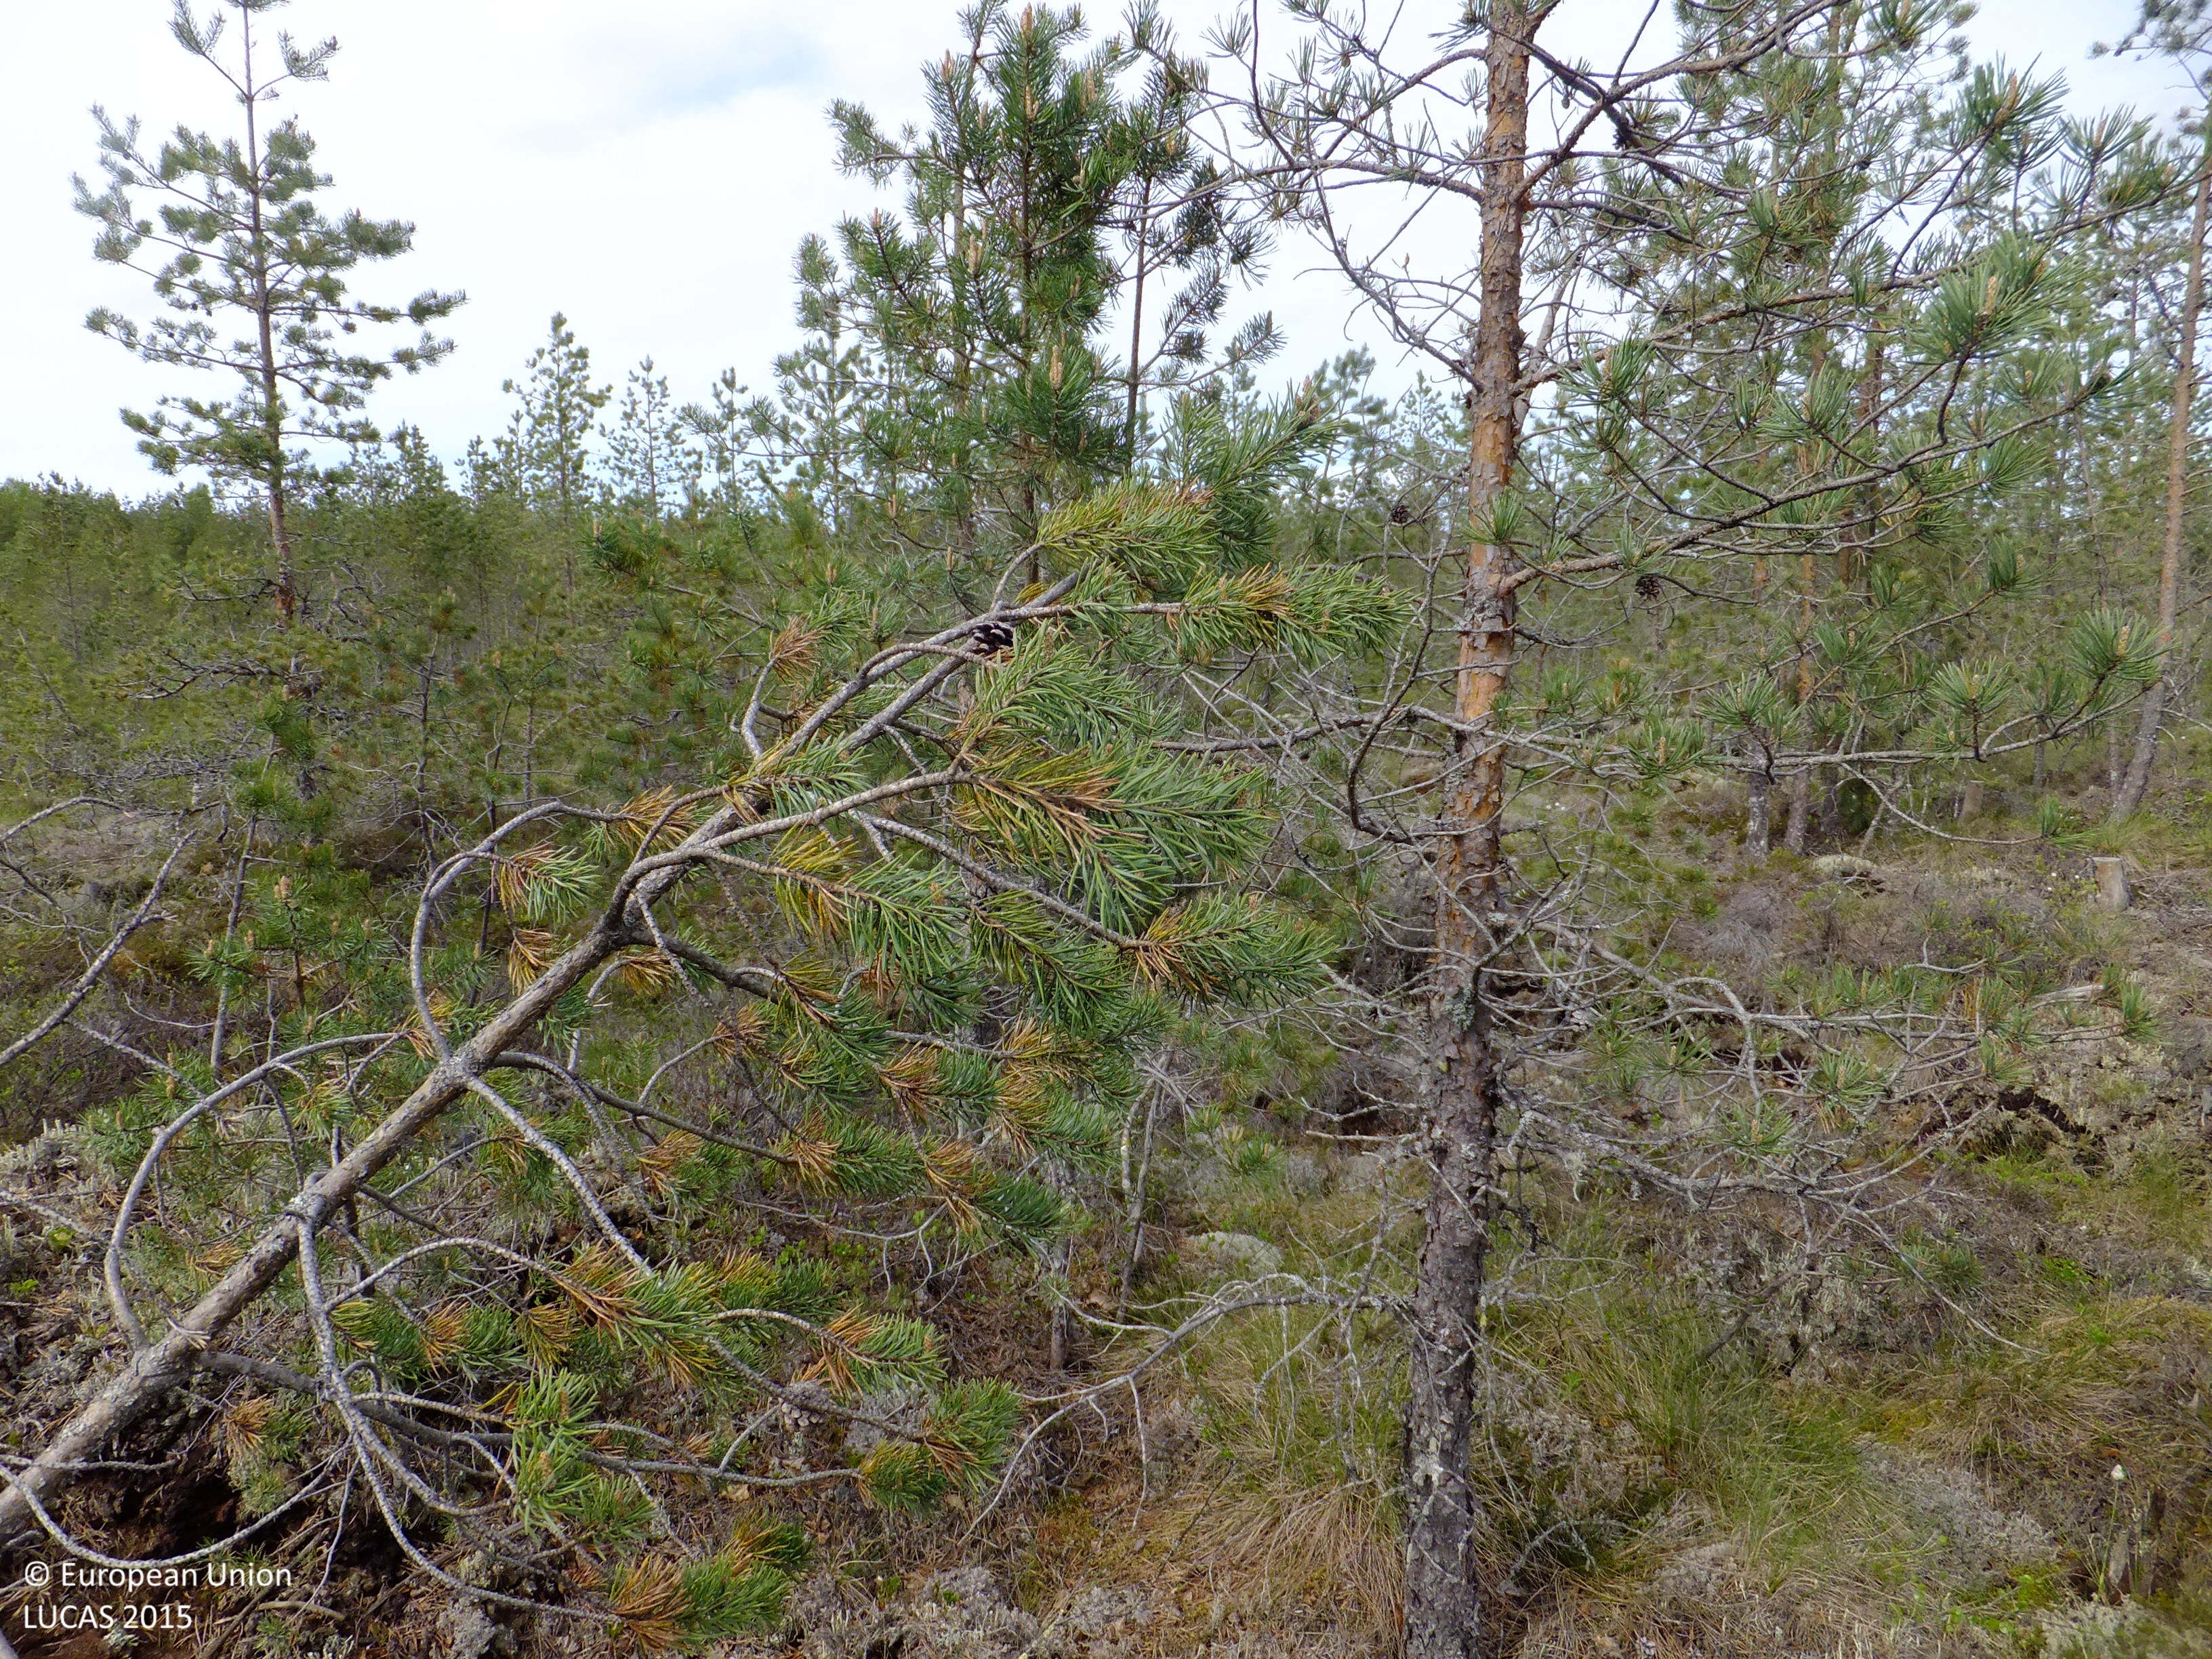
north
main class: Woodland
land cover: Pine dominated coniferous woodland
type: mire and swamp forests
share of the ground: > 75 %
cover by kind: coniferous forest trees 75 %, herbaceous plants 15 %, lichens and mosses 10 %
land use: Forestry
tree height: > 5 m
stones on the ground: < 10 %
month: June
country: FI
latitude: 63.4534
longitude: 22.8273
